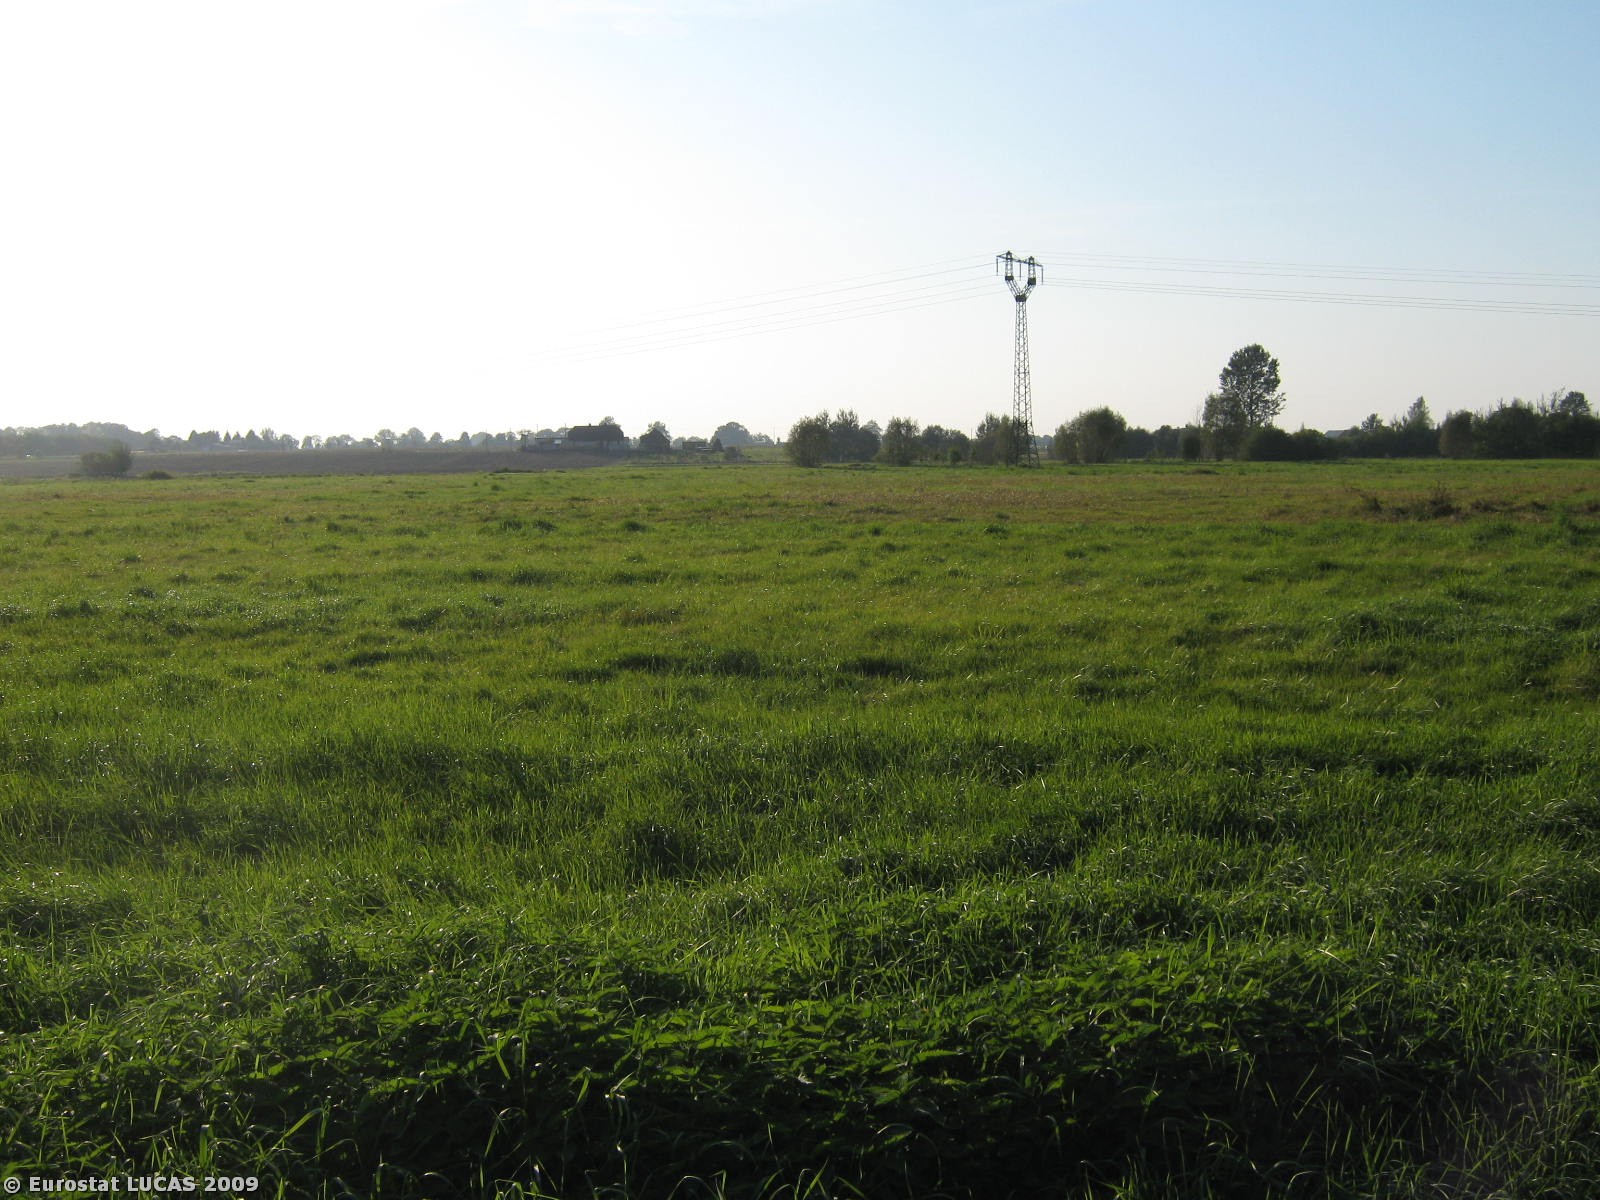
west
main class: Grassland
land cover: Grassland without tree/shrub cover
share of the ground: > 75 %
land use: Agriculture (excluding fallow land and kitchen gardens)
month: September
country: PL
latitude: 54.0475
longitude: 15.9761
